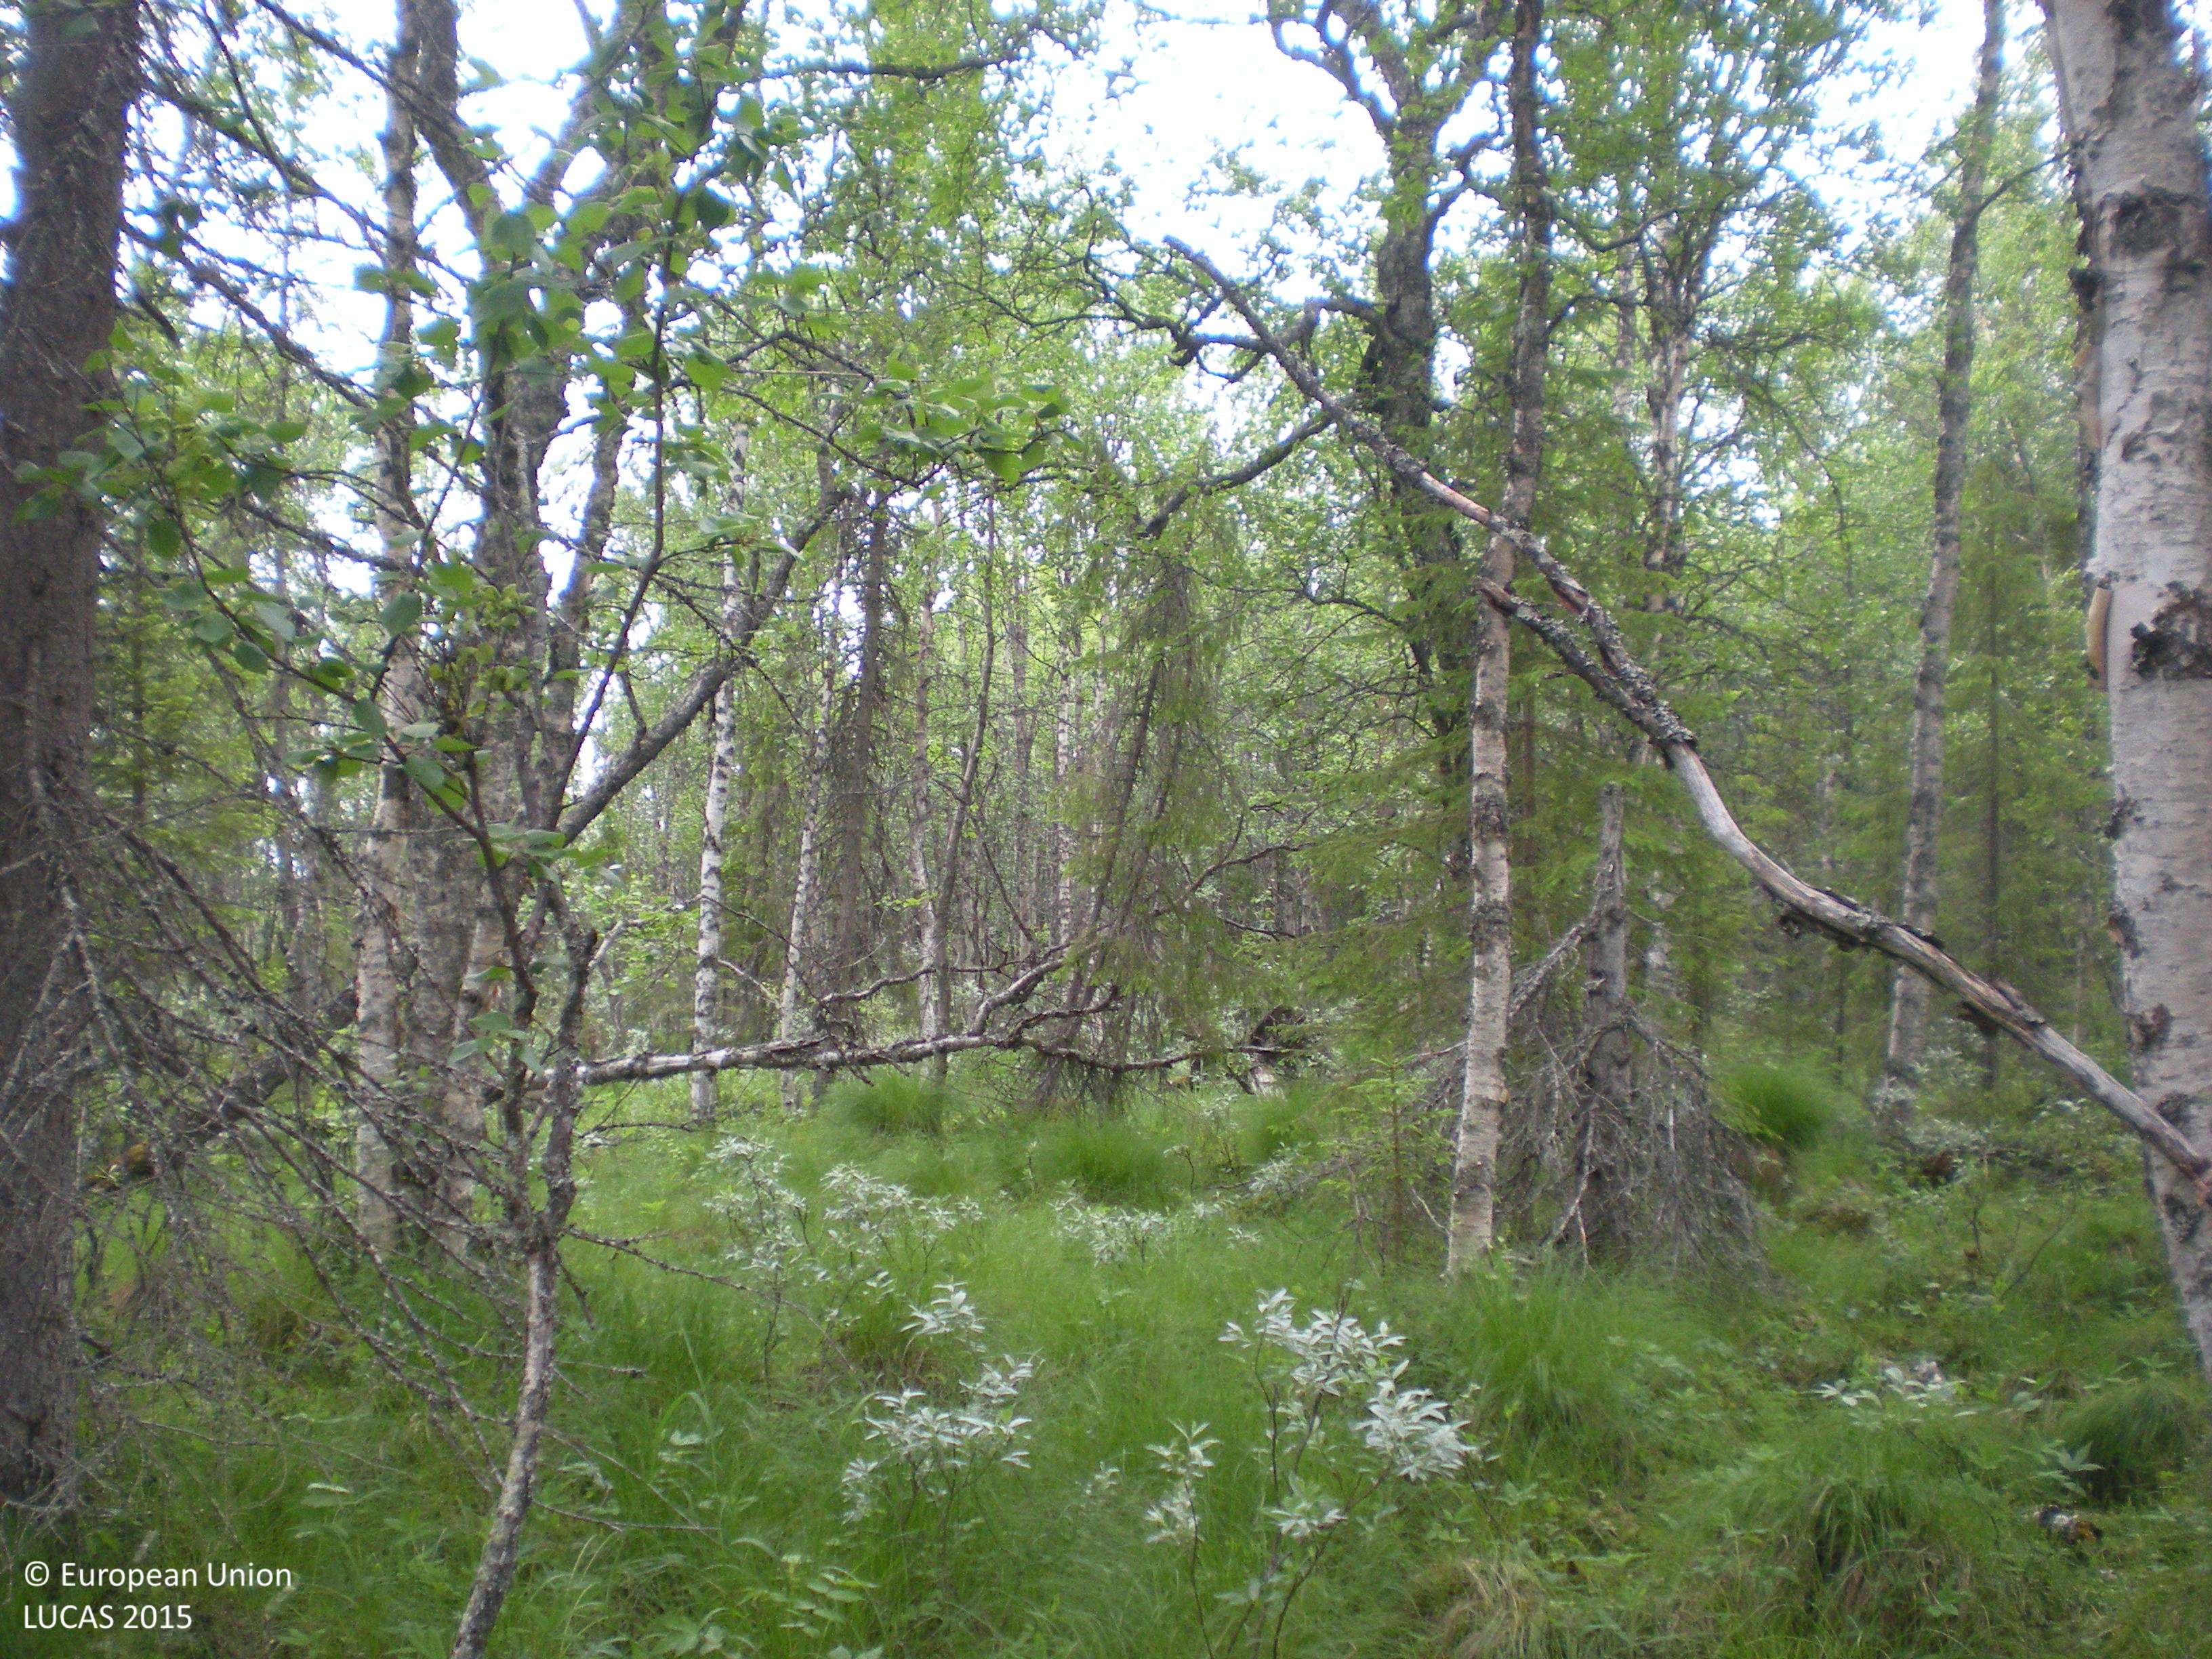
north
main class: Woodland
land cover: Spruce dominated mixed woodland
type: boreal forest
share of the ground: 50 - 75 %
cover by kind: broadleaved forest trees 40 %, coniferous forest trees 30 %, herbaceous plants 20 %, shrubs 5 %, lichens and mosses 5 %
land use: Semi-natural and natural areas not in use
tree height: > 5 m
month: July
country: SE
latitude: 65.6387
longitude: 18.2364
